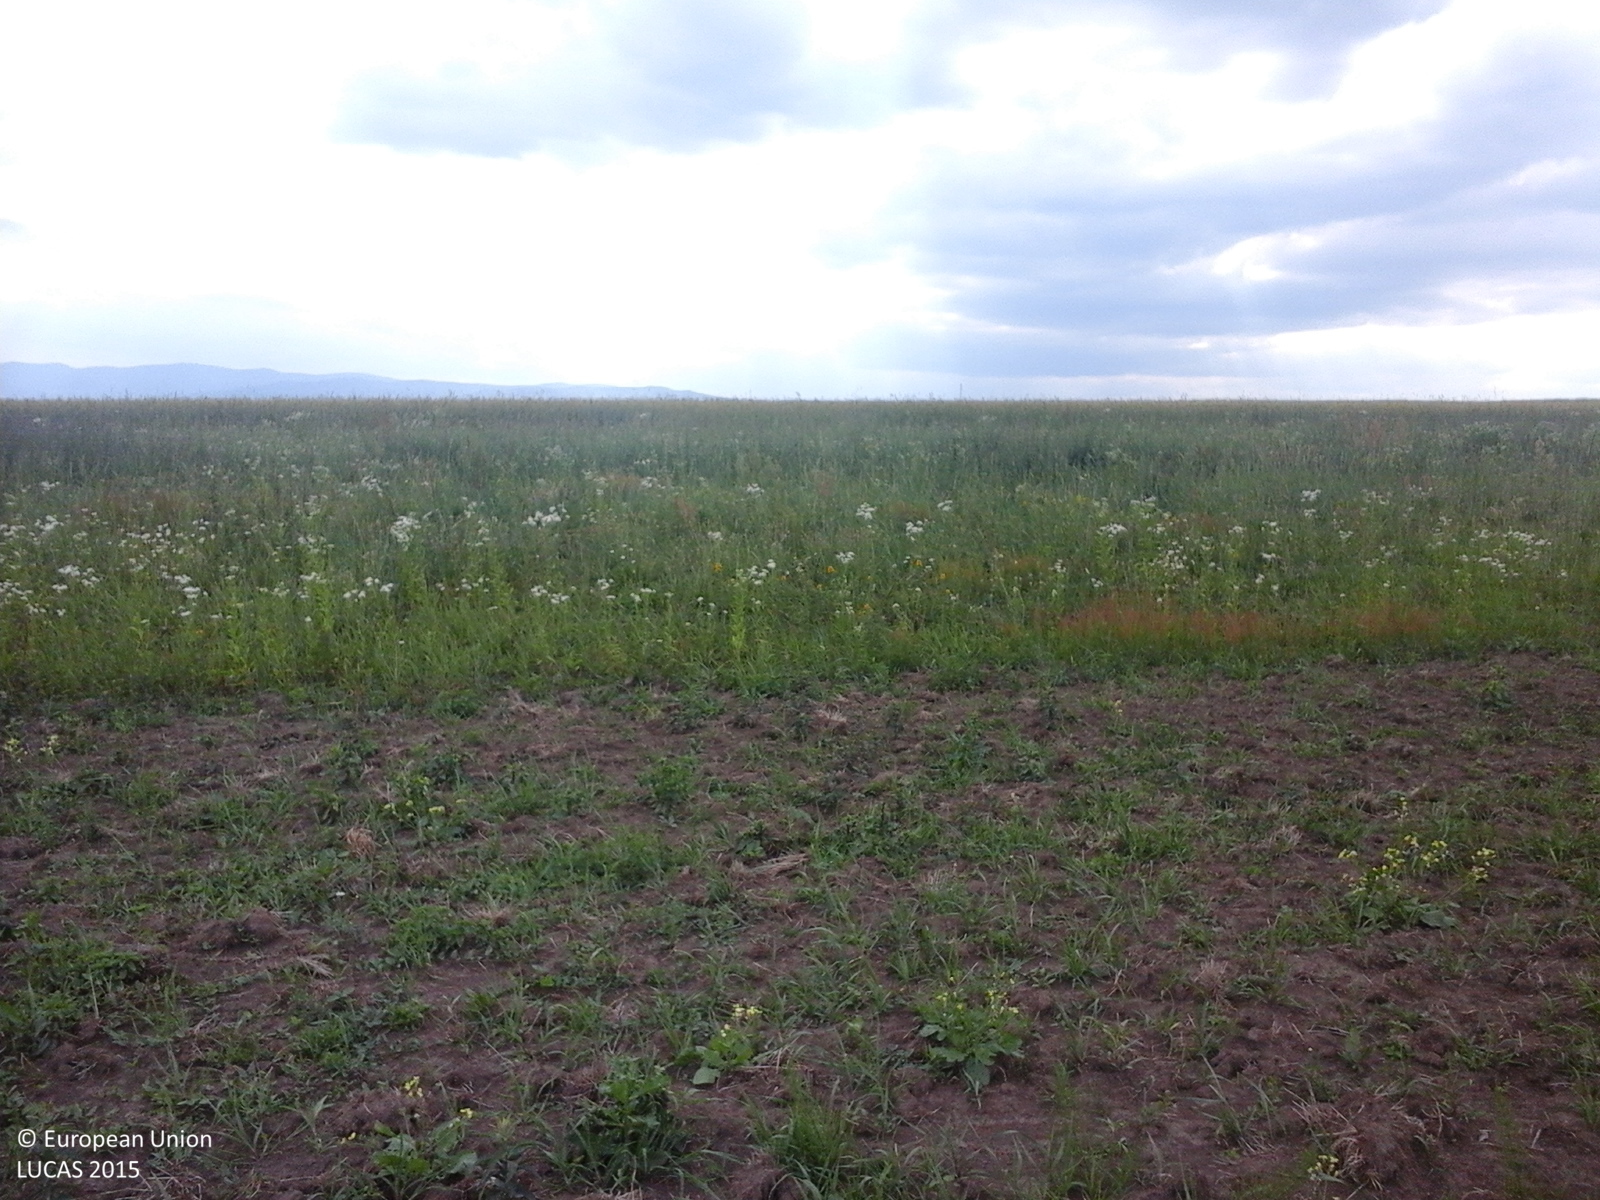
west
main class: Grassland
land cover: Spontaneously vegetated surfaces
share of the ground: 10 - 25 %
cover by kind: herbaceous plants 100 %
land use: Fallow land
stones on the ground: < 10 %
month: June
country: RO
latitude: 47.7476
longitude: 25.9614
